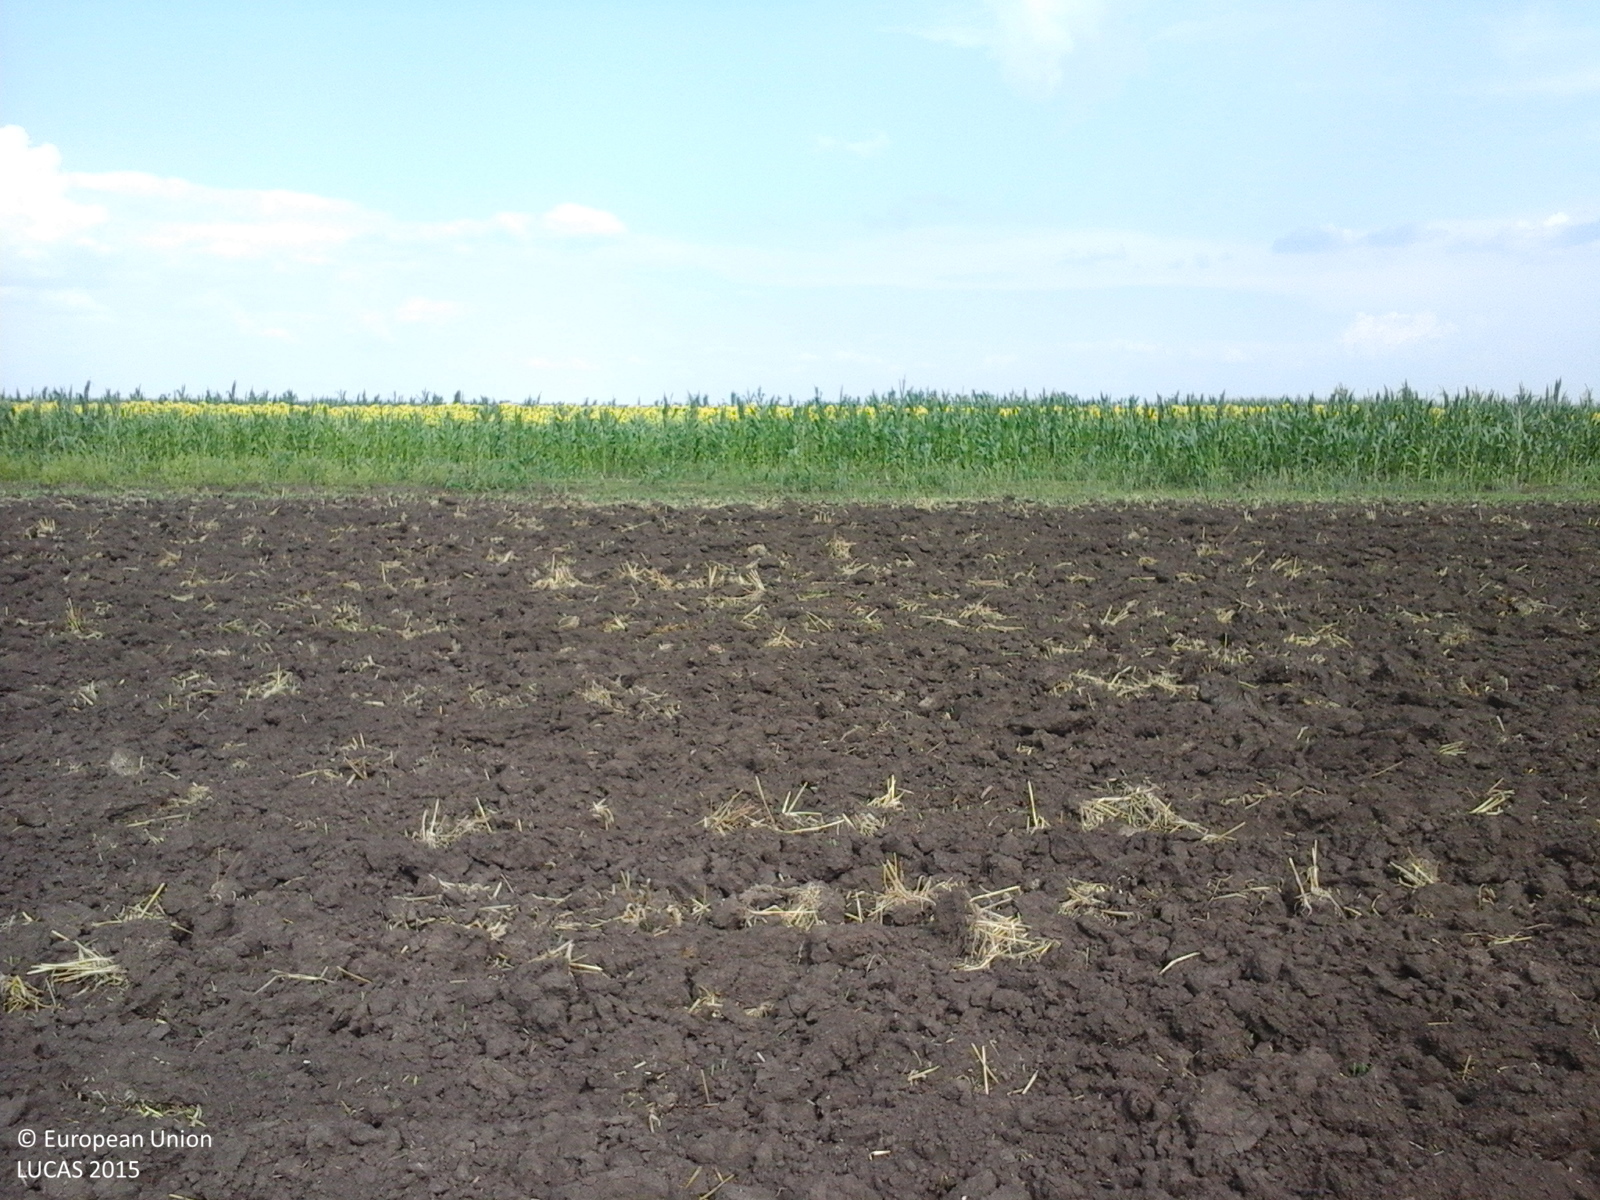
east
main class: Cropland
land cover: Common wheat
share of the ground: < 10 %
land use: Agriculture (excluding fallow land and kitchen gardens)
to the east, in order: Common wheat; Maize; Sunflower; Common wheat; Maize; Common wheat; Sunflower; Maize; Other bare soil; Maize; Common wheat; Sunflower; Other bare soil; Maize
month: July
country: RO
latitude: 44.0159
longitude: 25.7732
